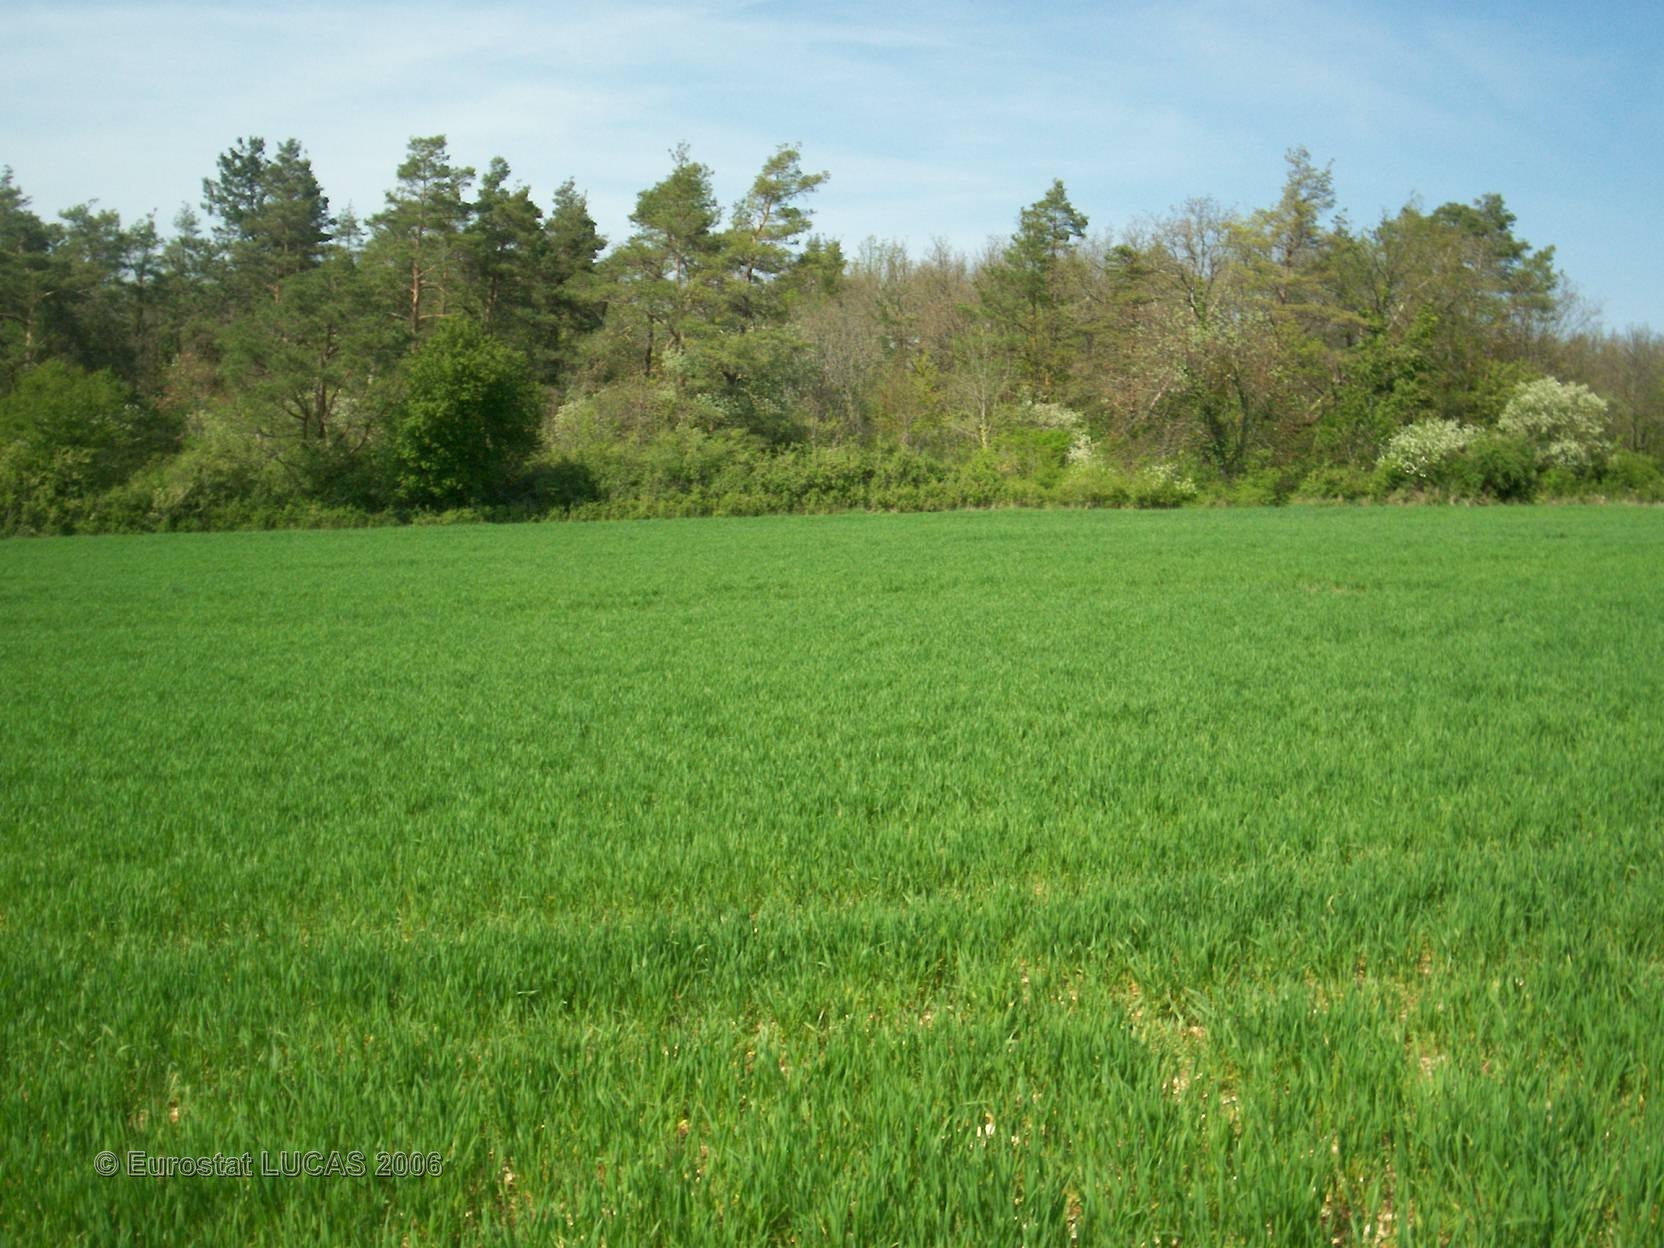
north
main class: Cropland
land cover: Common wheat
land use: Agriculture (excluding fallow land and kitchen gardens)
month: May
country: FR
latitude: 47.5317
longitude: 4.5930
